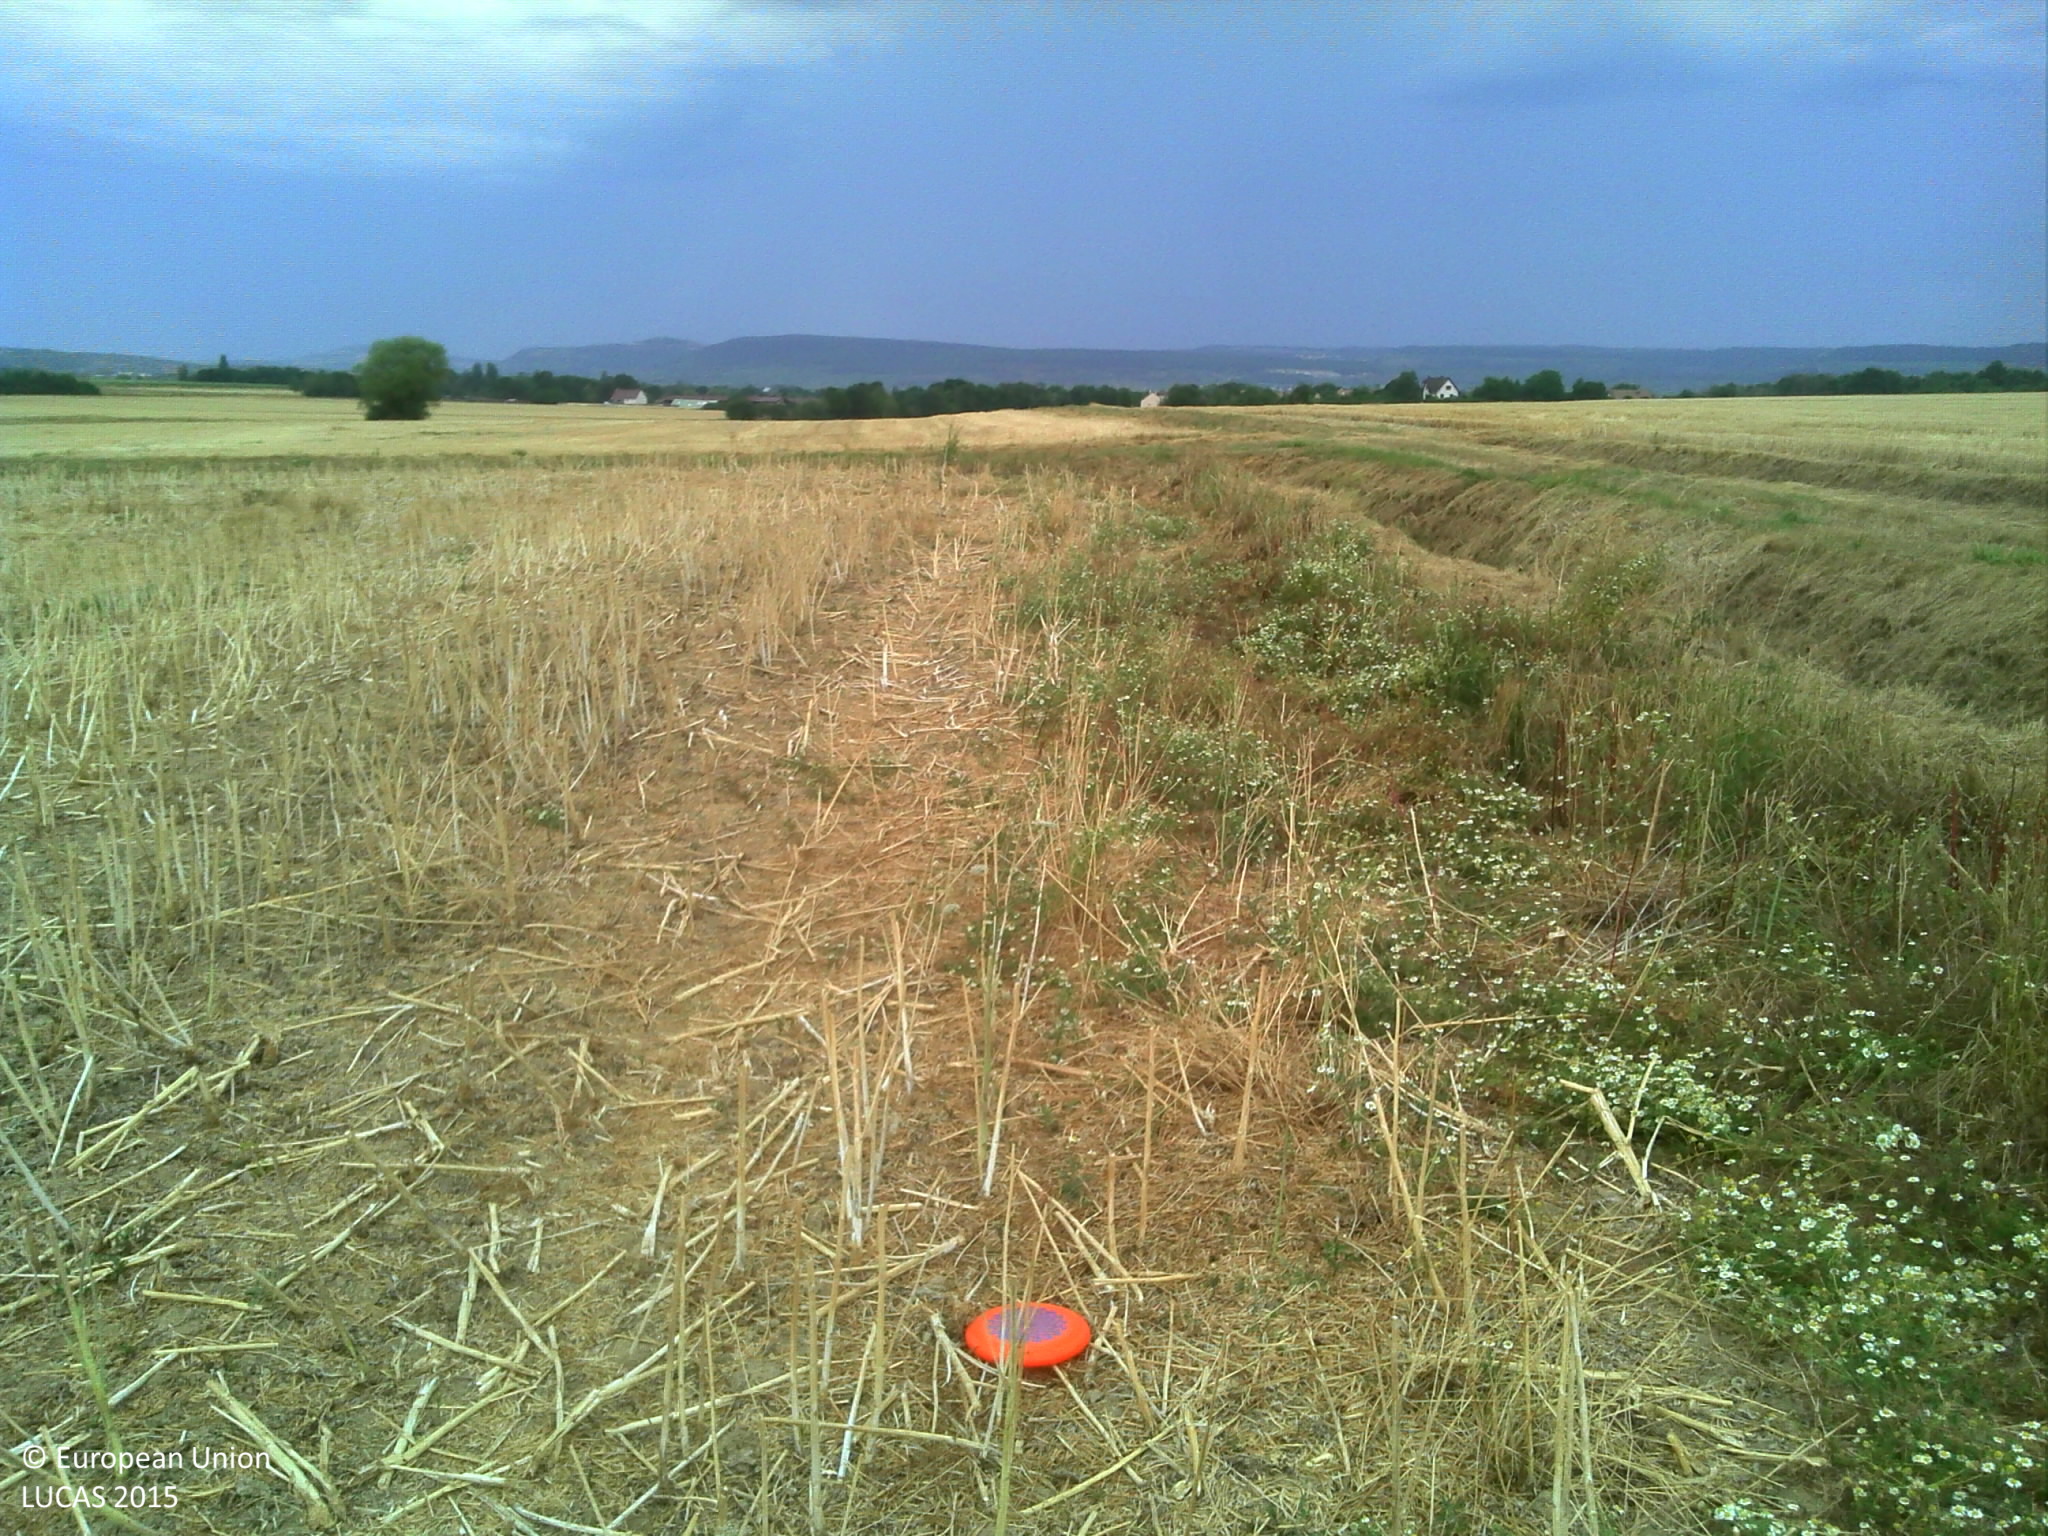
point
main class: Cropland
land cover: Rape and turnip rape
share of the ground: < 10 %
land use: Agriculture (excluding fallow land and kitchen gardens)
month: July
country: FR
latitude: 46.9112
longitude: 4.8148
